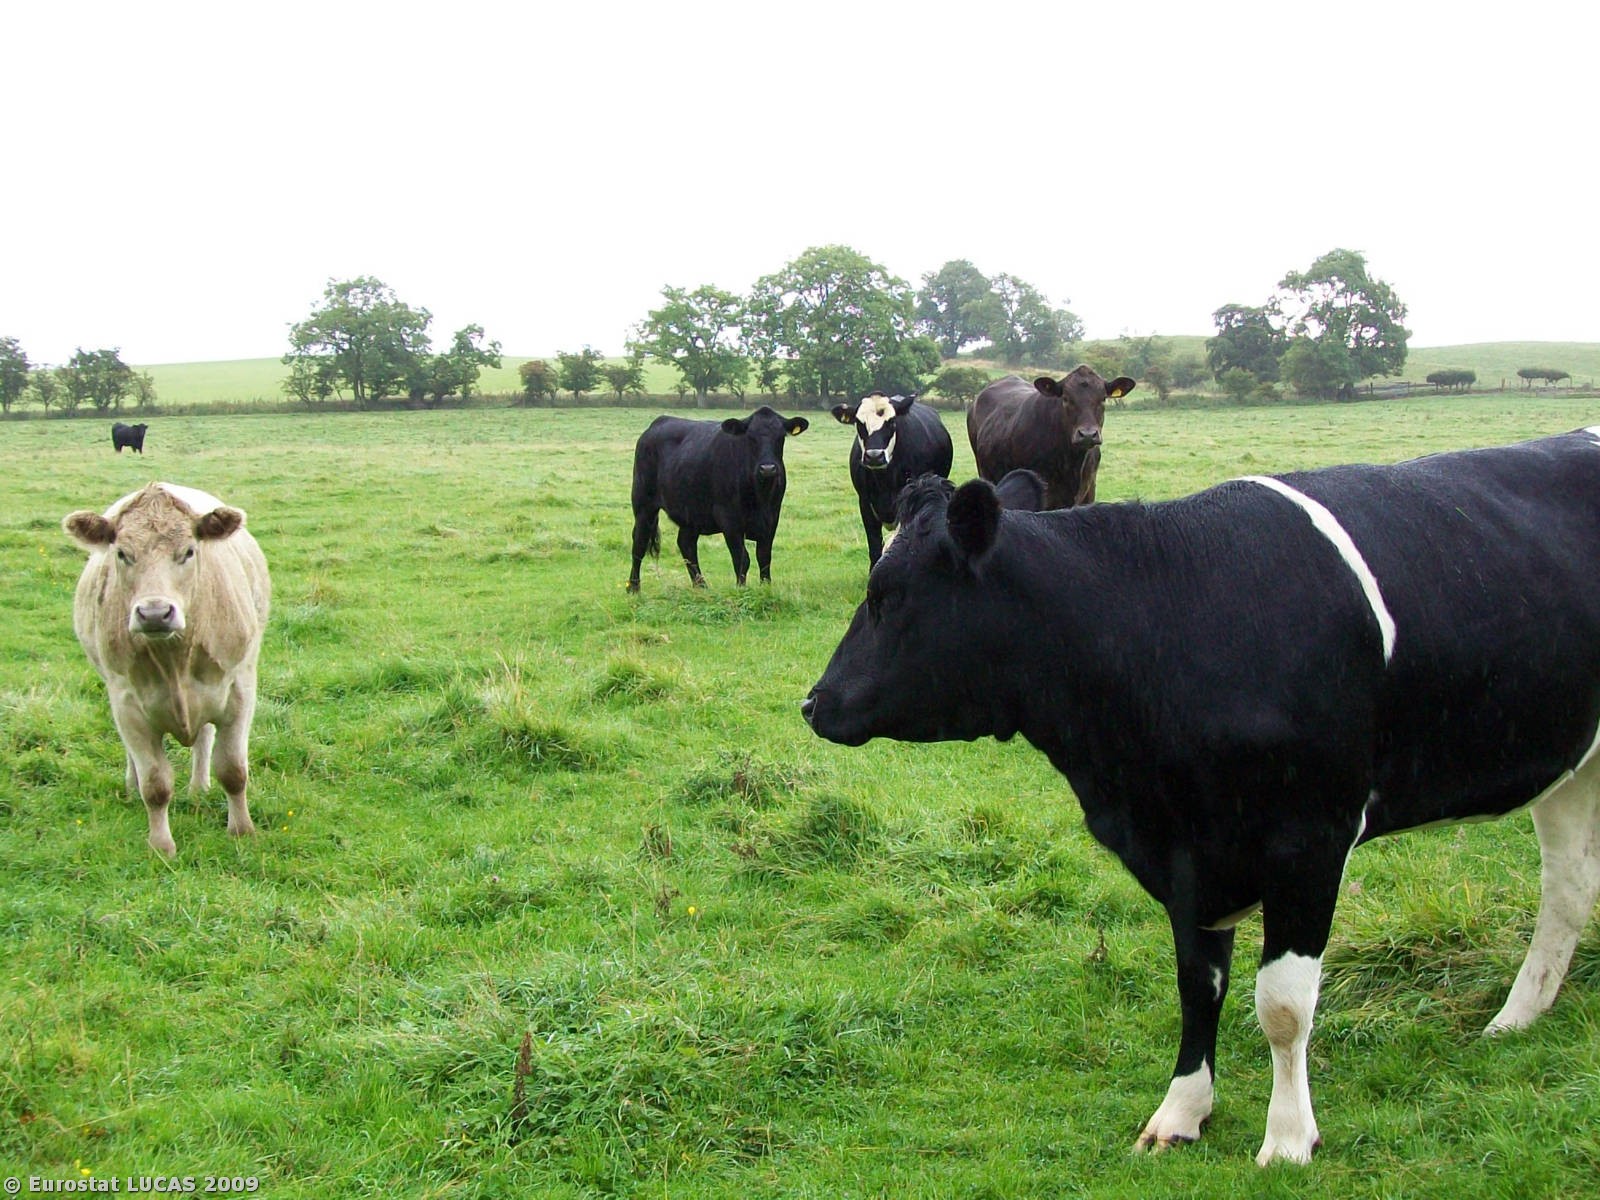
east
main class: Grassland
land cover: Grassland without tree/shrub cover
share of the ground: > 75 %
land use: Agriculture (excluding fallow land and kitchen gardens)
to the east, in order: Grassland without tree/shrub cover; Electric lines; Grassland without tree/shrub cover; Tracks; Managed hedges; Fences; Grassland without tree/shrub cover
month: September
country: GB
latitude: 55.2940
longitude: -1.8151
